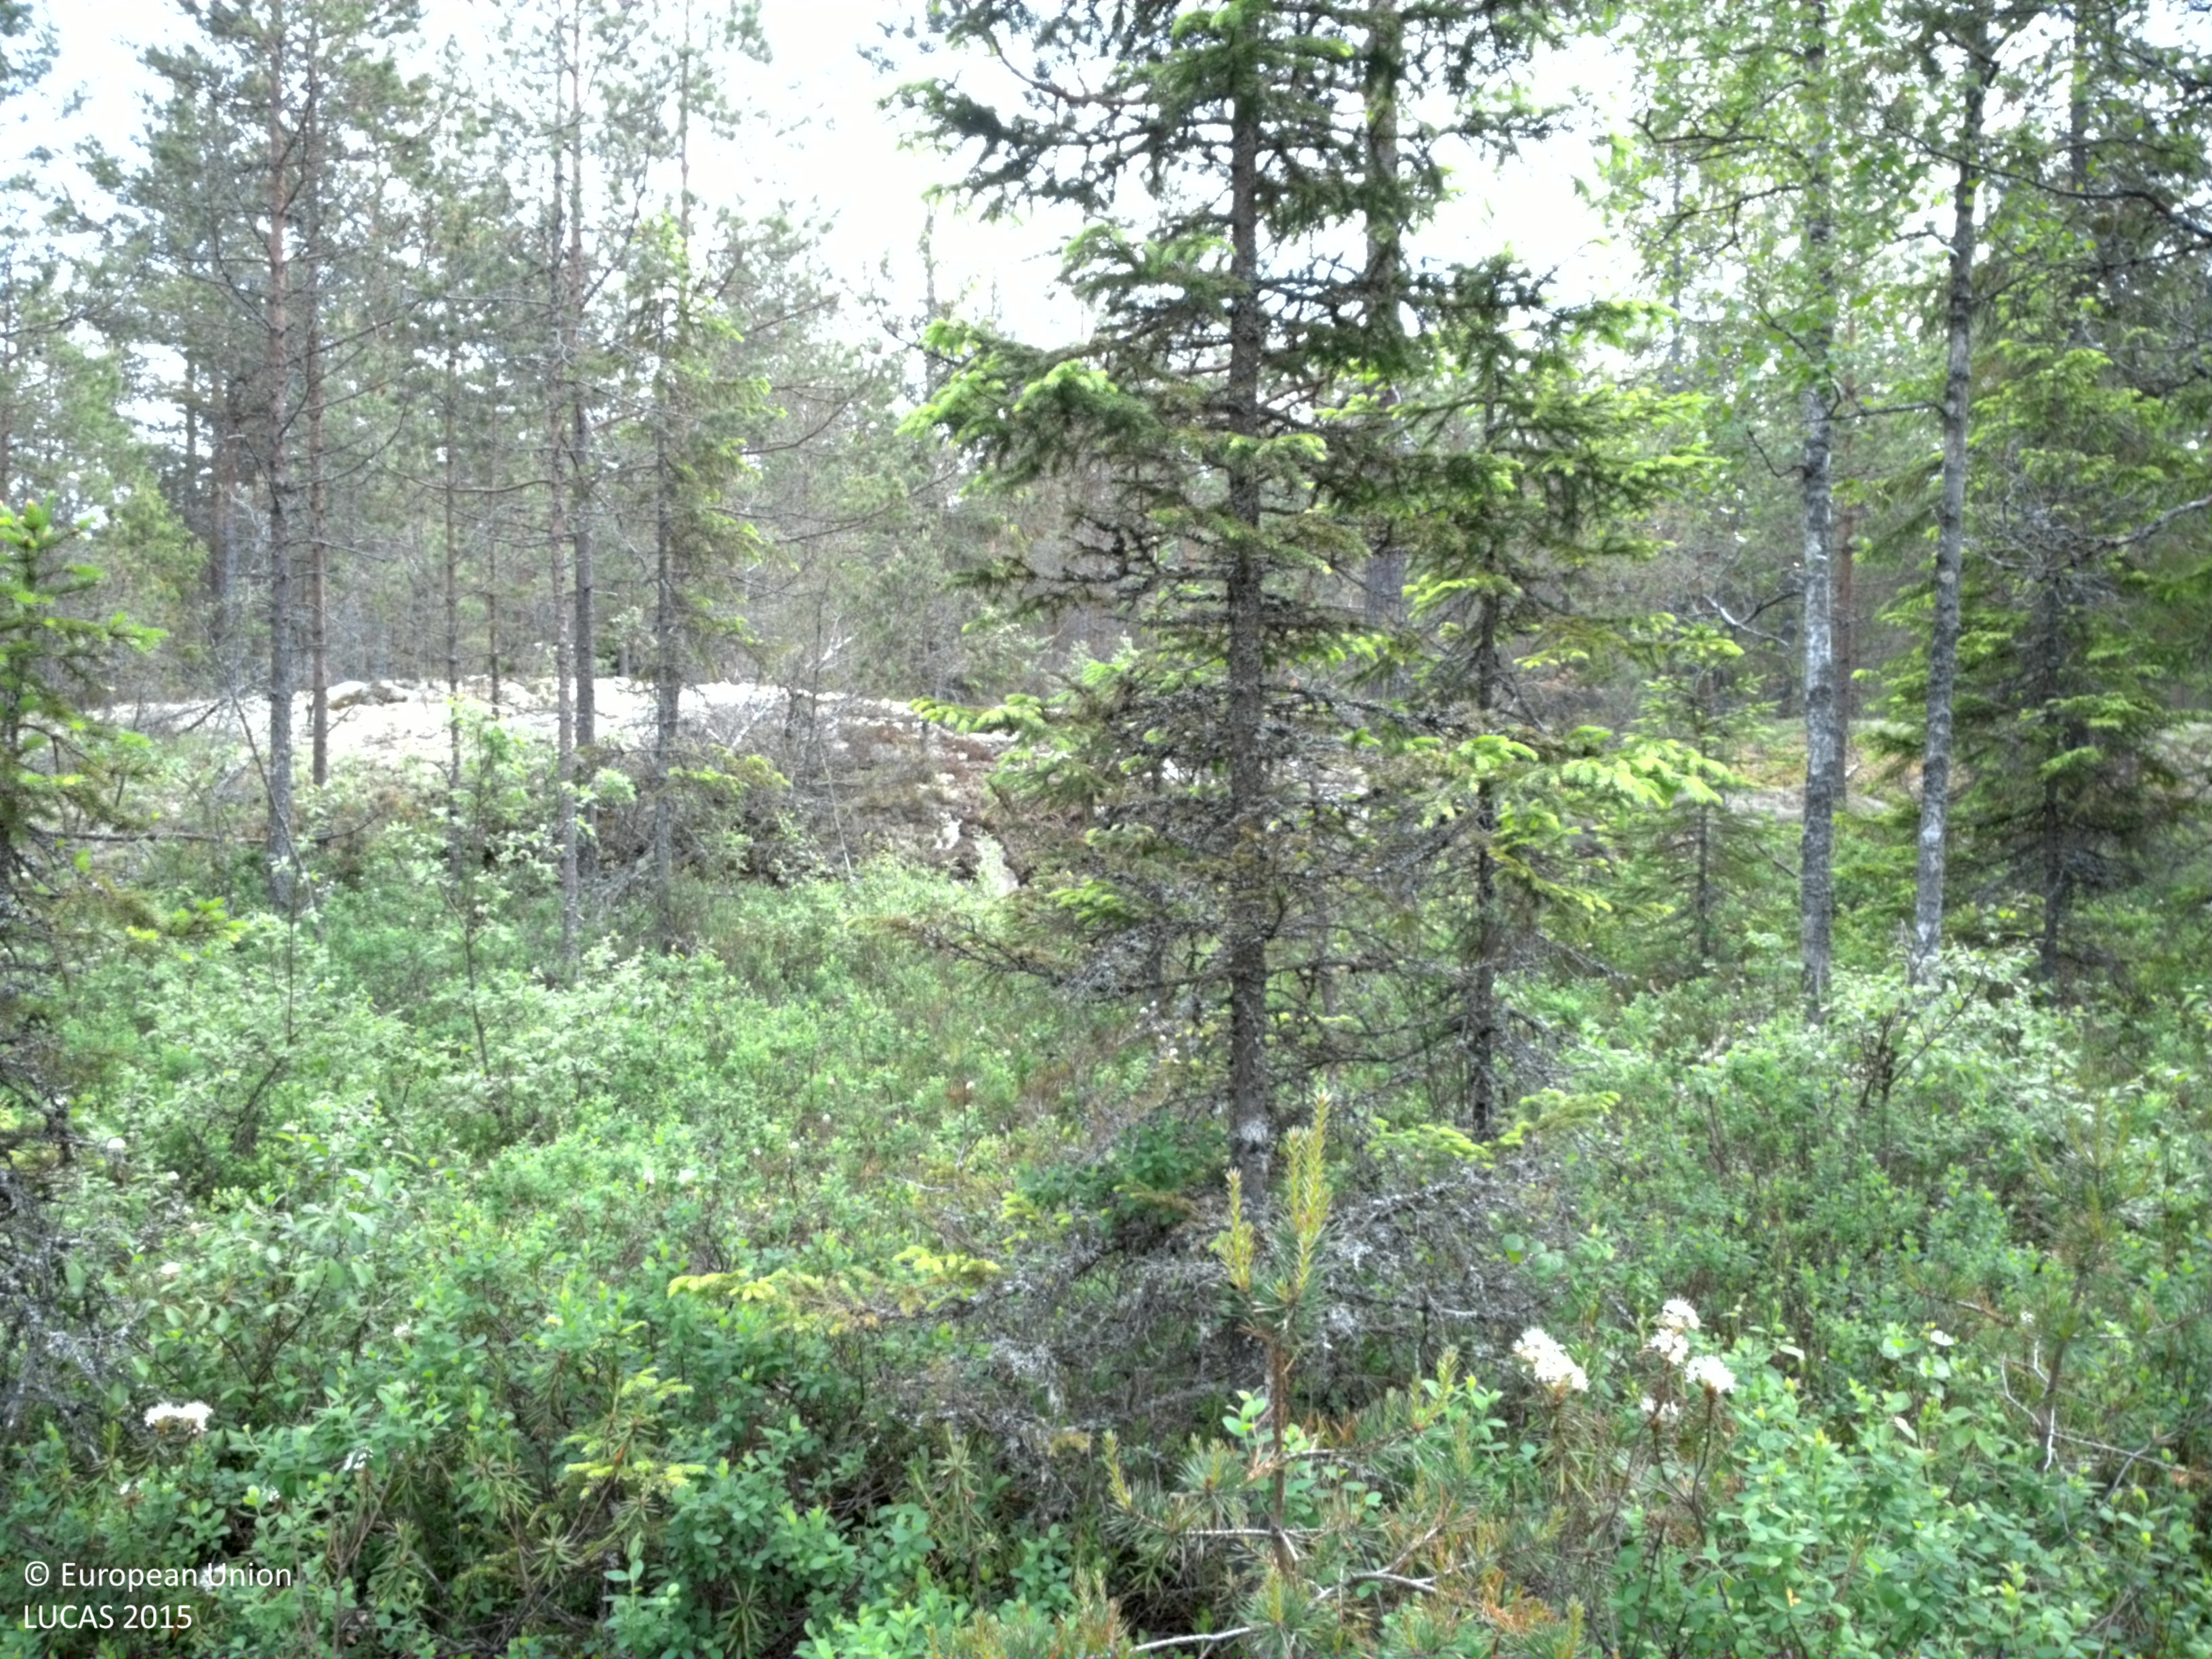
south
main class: Woodland
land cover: Pine dominated coniferous woodland
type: boreal forest
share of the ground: 25 - 50 %
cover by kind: coniferous forest trees 45 %, lichens and mosses 30 %, shrubs 20 %, broadleaved forest trees 5 %
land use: Forestry
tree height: > 5 m
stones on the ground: < 10 %
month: June
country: SE
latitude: 59.9977
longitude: 17.1817
